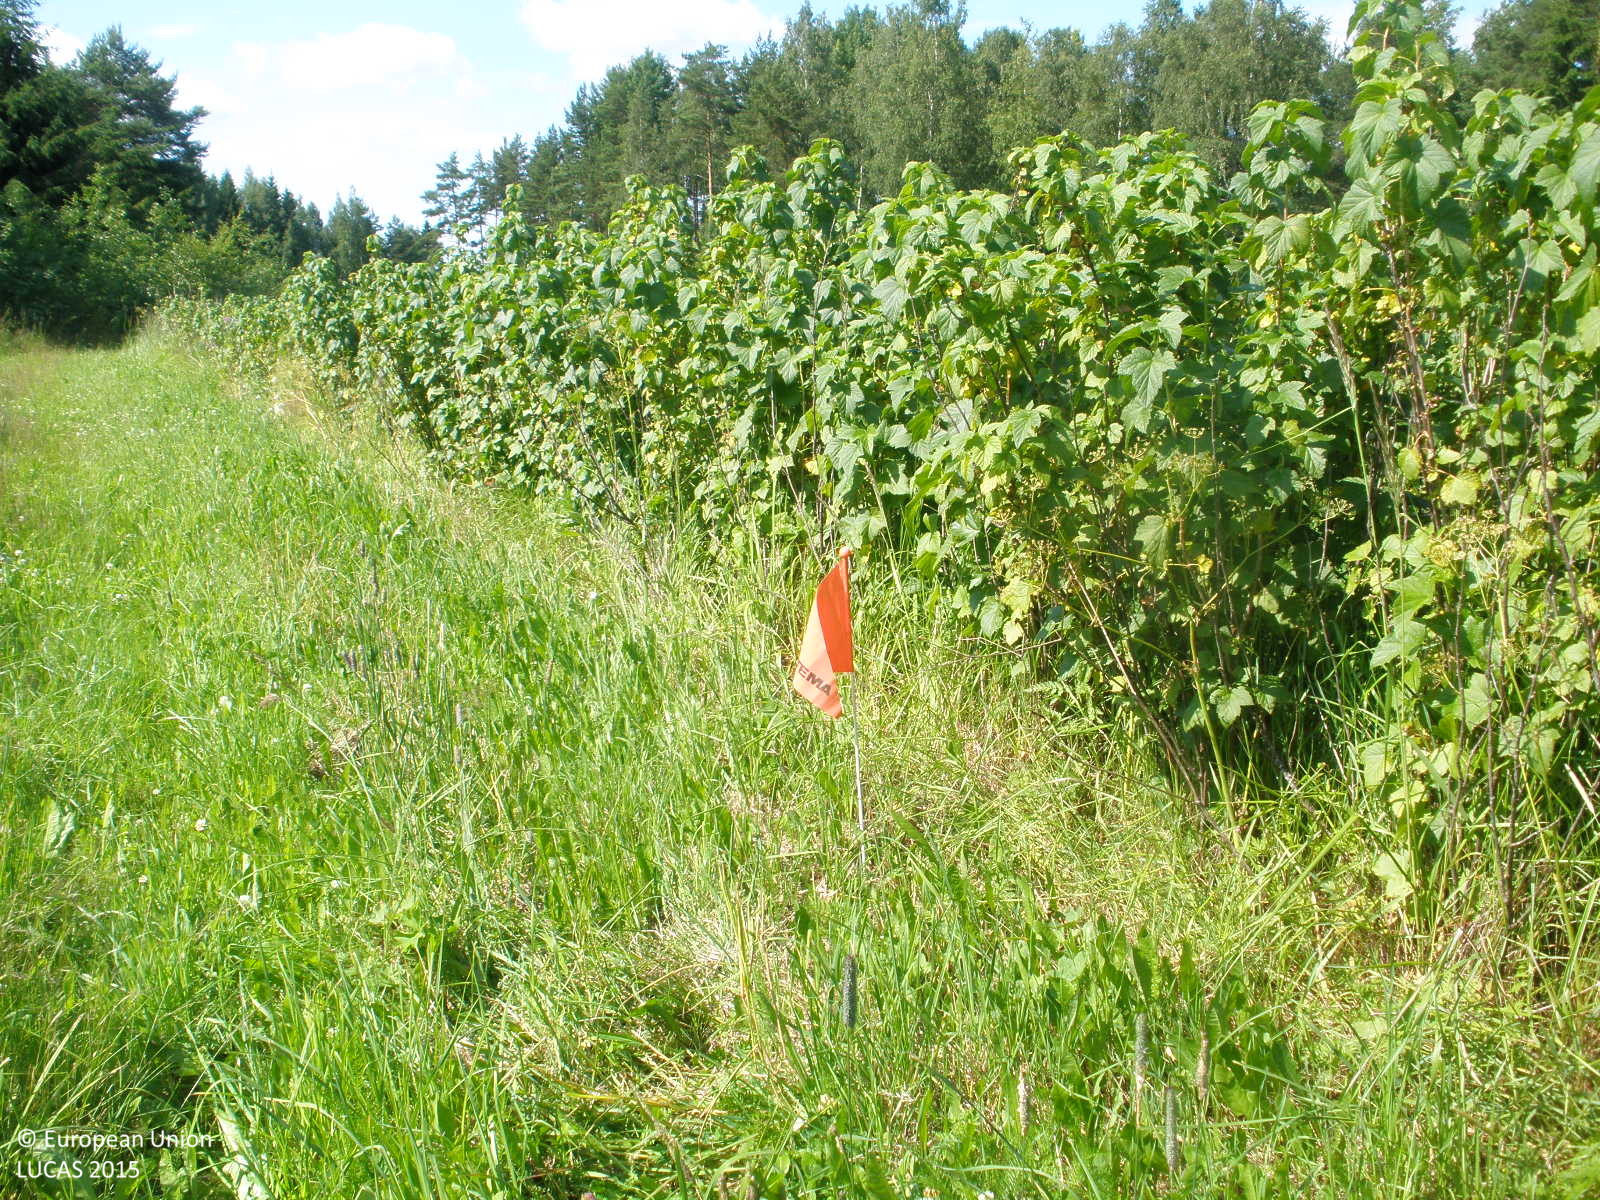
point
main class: Cropland
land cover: Other fruit trees and berries
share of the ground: 25 - 50 %
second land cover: Grassland without tree/shrub cover
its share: 50 - 75 %
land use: Agriculture (excluding fallow land and kitchen gardens)
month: July
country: FI
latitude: 61.5145
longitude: 24.3614
